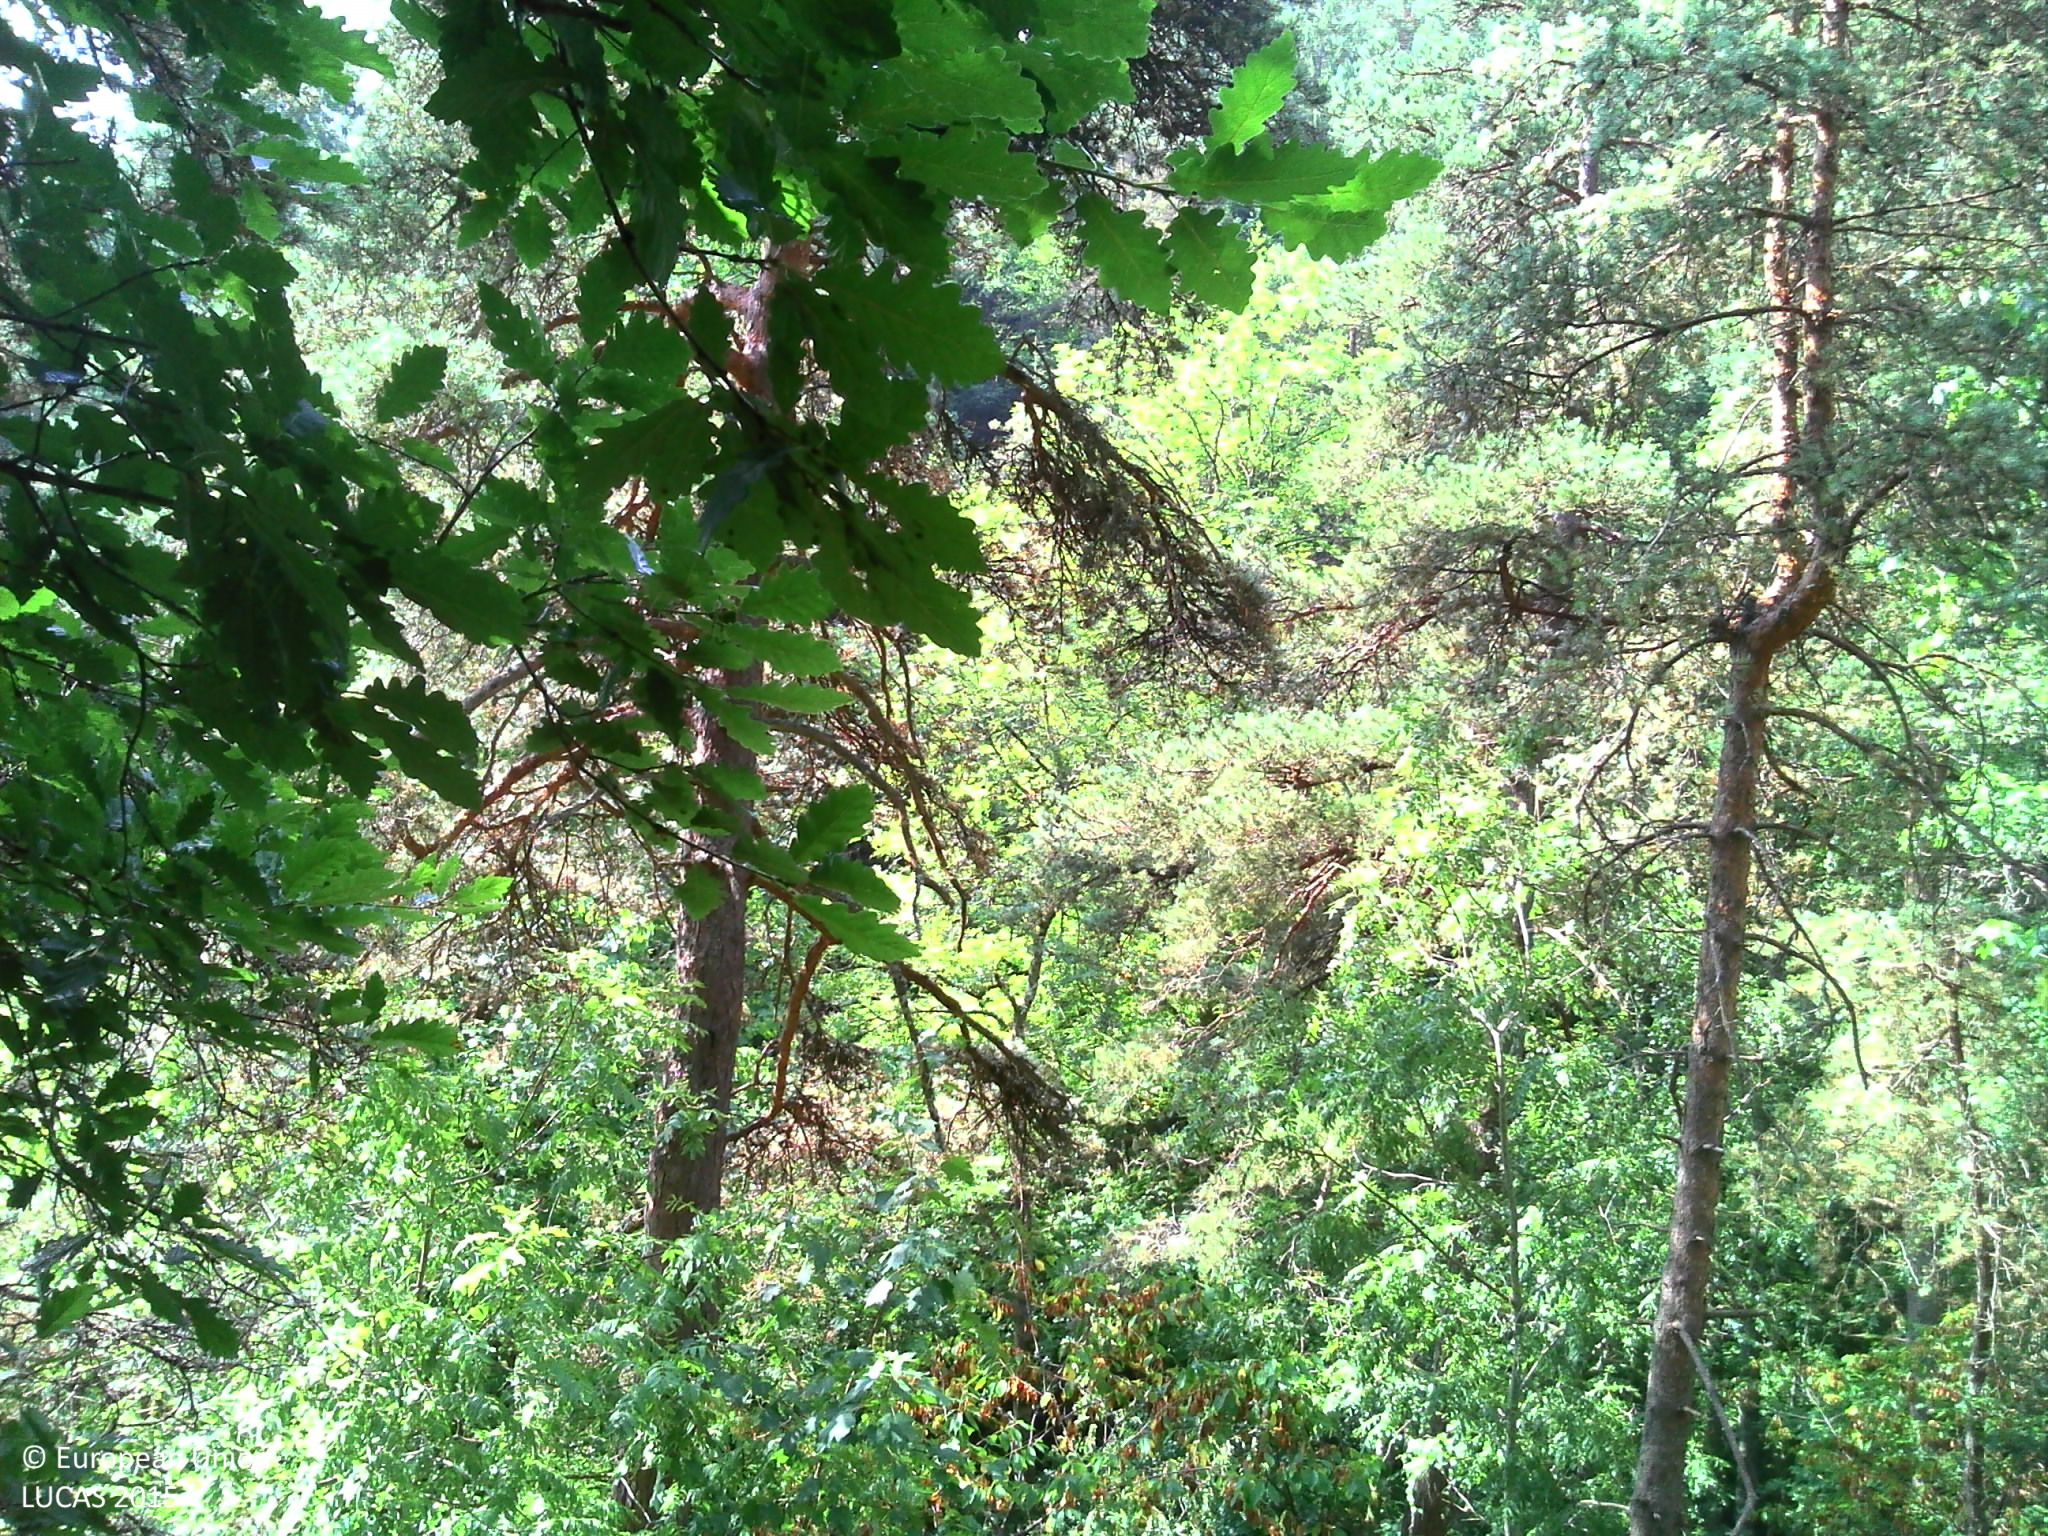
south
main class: Woodland
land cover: Pine dominated mixed woodland
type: mesophytic deciduous forest
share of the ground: > 75 %
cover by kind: broadleaved forest trees 65 %, coniferous forest trees 25 %, herbaceous plants 10 %
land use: Forestry
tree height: > 5 m
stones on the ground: < 10 %
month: July
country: FR
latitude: 45.1624
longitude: 4.1649
